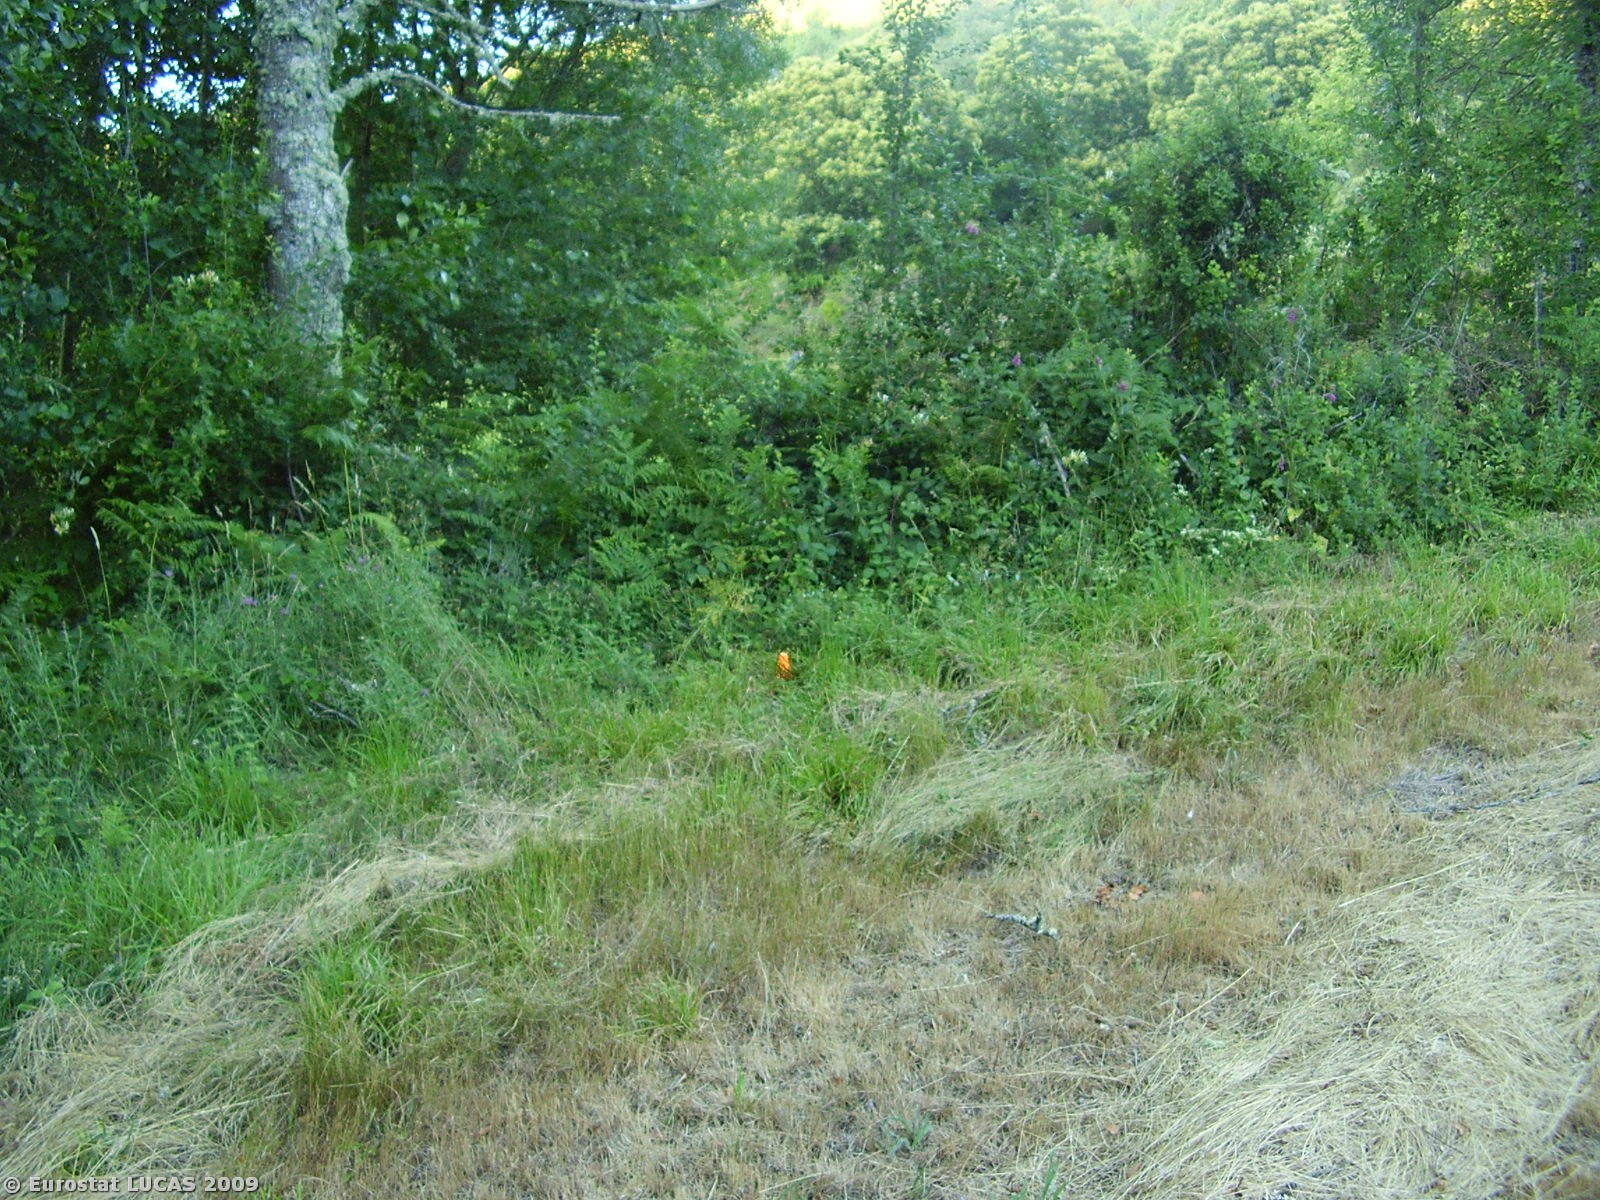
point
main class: Grassland
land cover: Grassland without tree/shrub cover
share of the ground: > 75 %
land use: Agriculture (excluding fallow land and kitchen gardens)
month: July
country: PT
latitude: 41.5327
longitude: -7.5438
